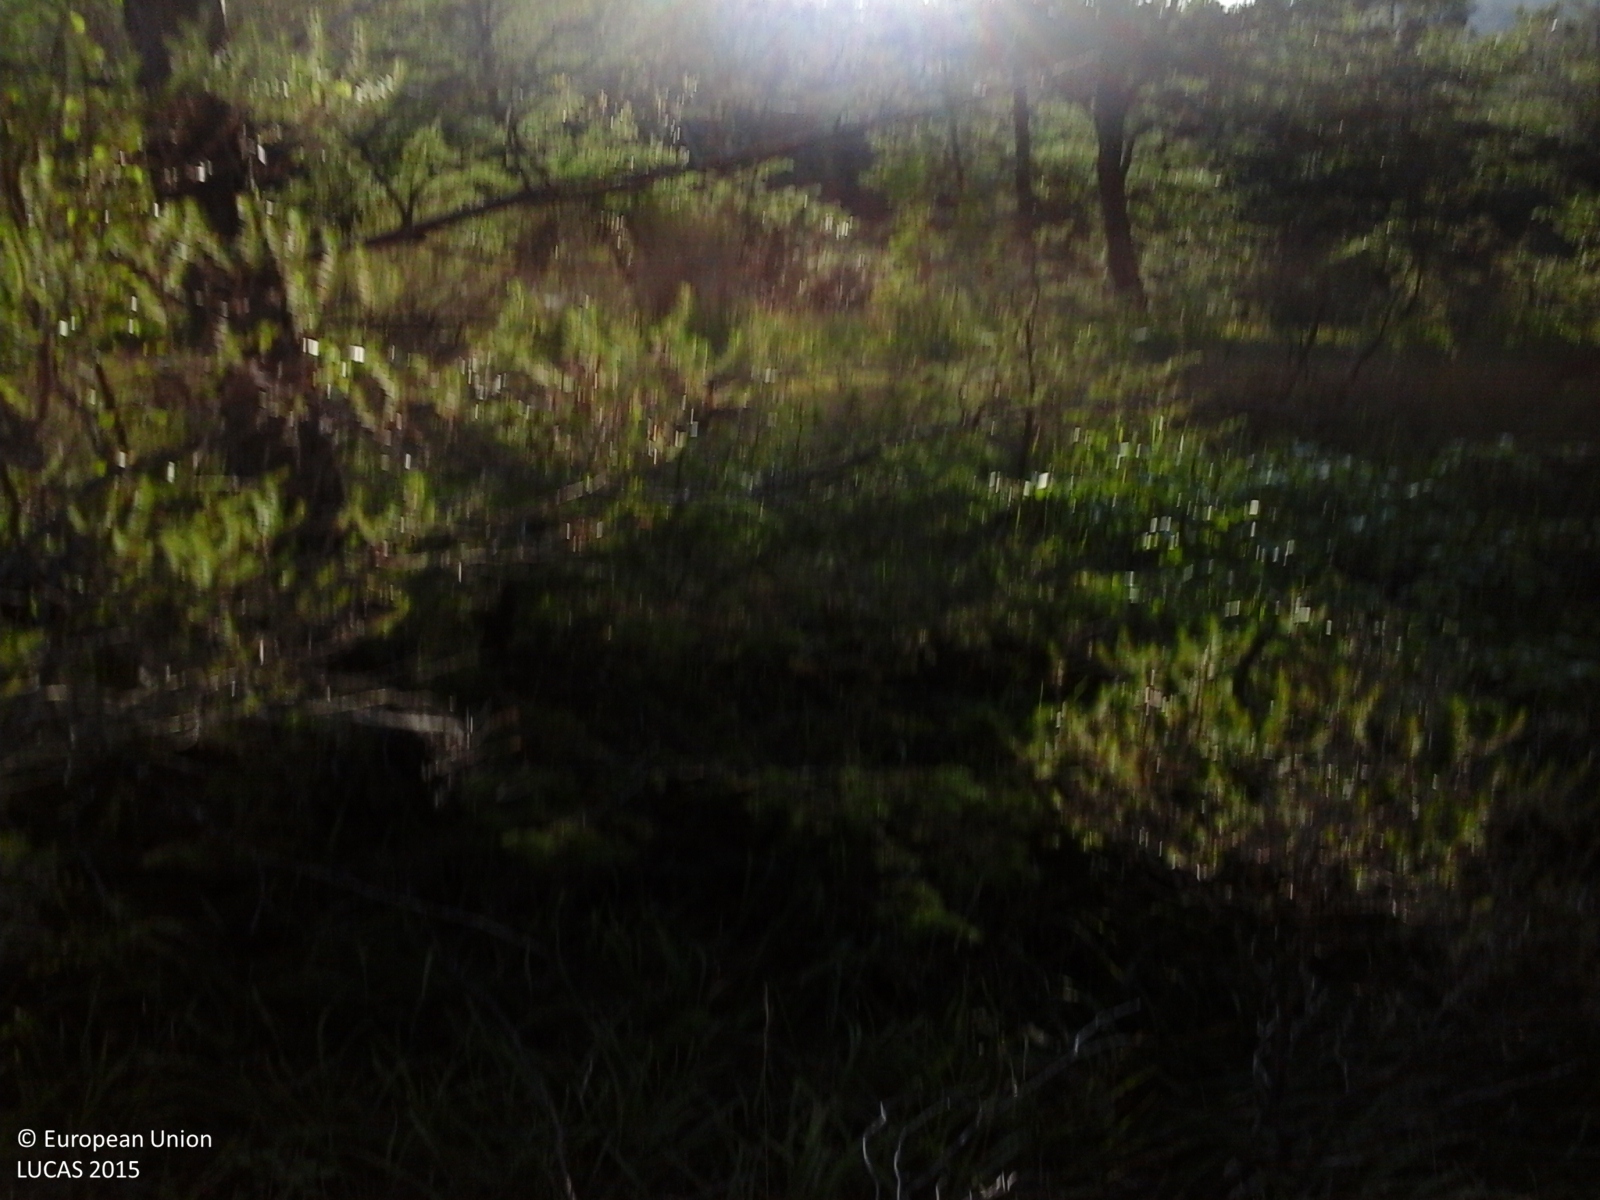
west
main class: Woodland
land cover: Pine dominated mixed woodland
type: coniferous forest of the mediterranean region
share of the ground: > 75 %
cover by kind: coniferous forest trees 45 %, broadleaved forest trees 25 %, shrubs 20 %, herbaceous plants 10 %
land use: Forestry
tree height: > 5 m
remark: Clear cut
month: August
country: IT
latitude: 42.7856
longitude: 11.6206
